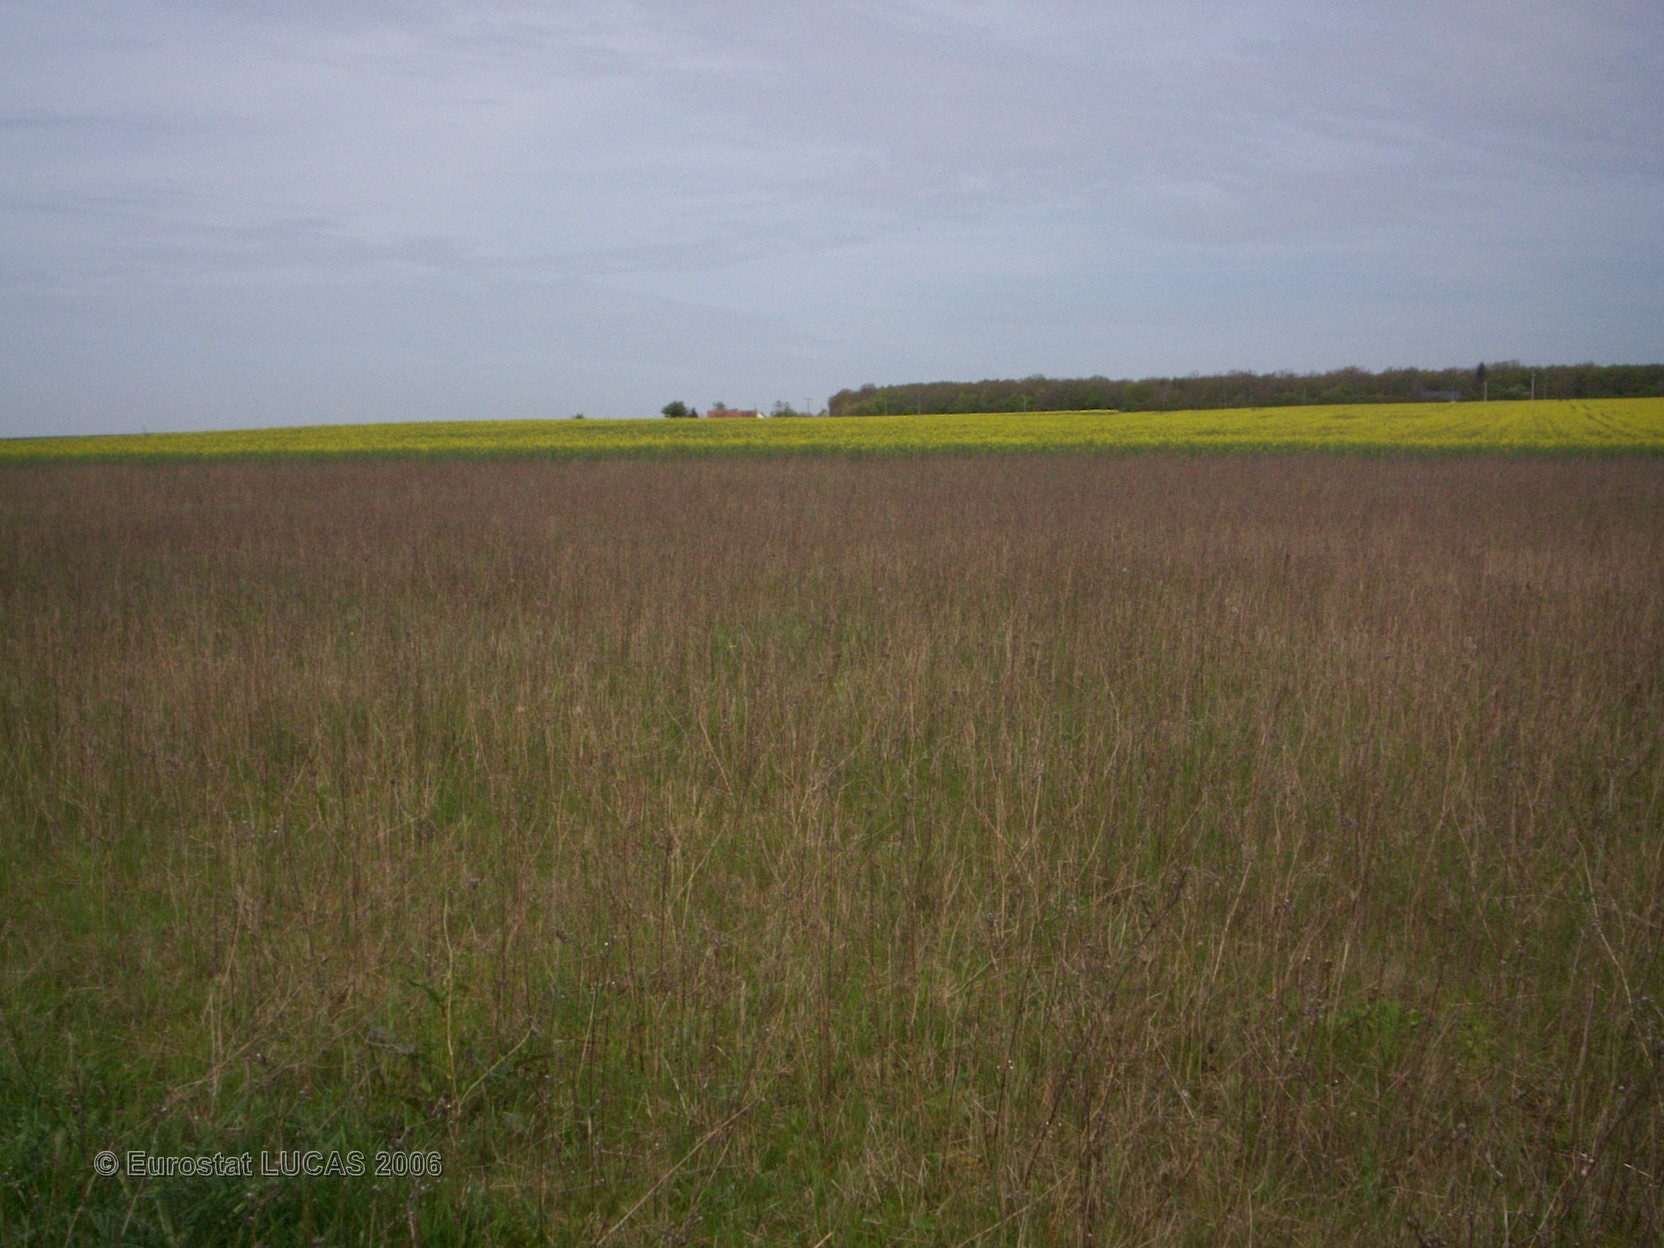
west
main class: Grassland
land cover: Grassland without tree/shrub cover
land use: Fallow land
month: May
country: FR
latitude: 47.2835
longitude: 3.0806
